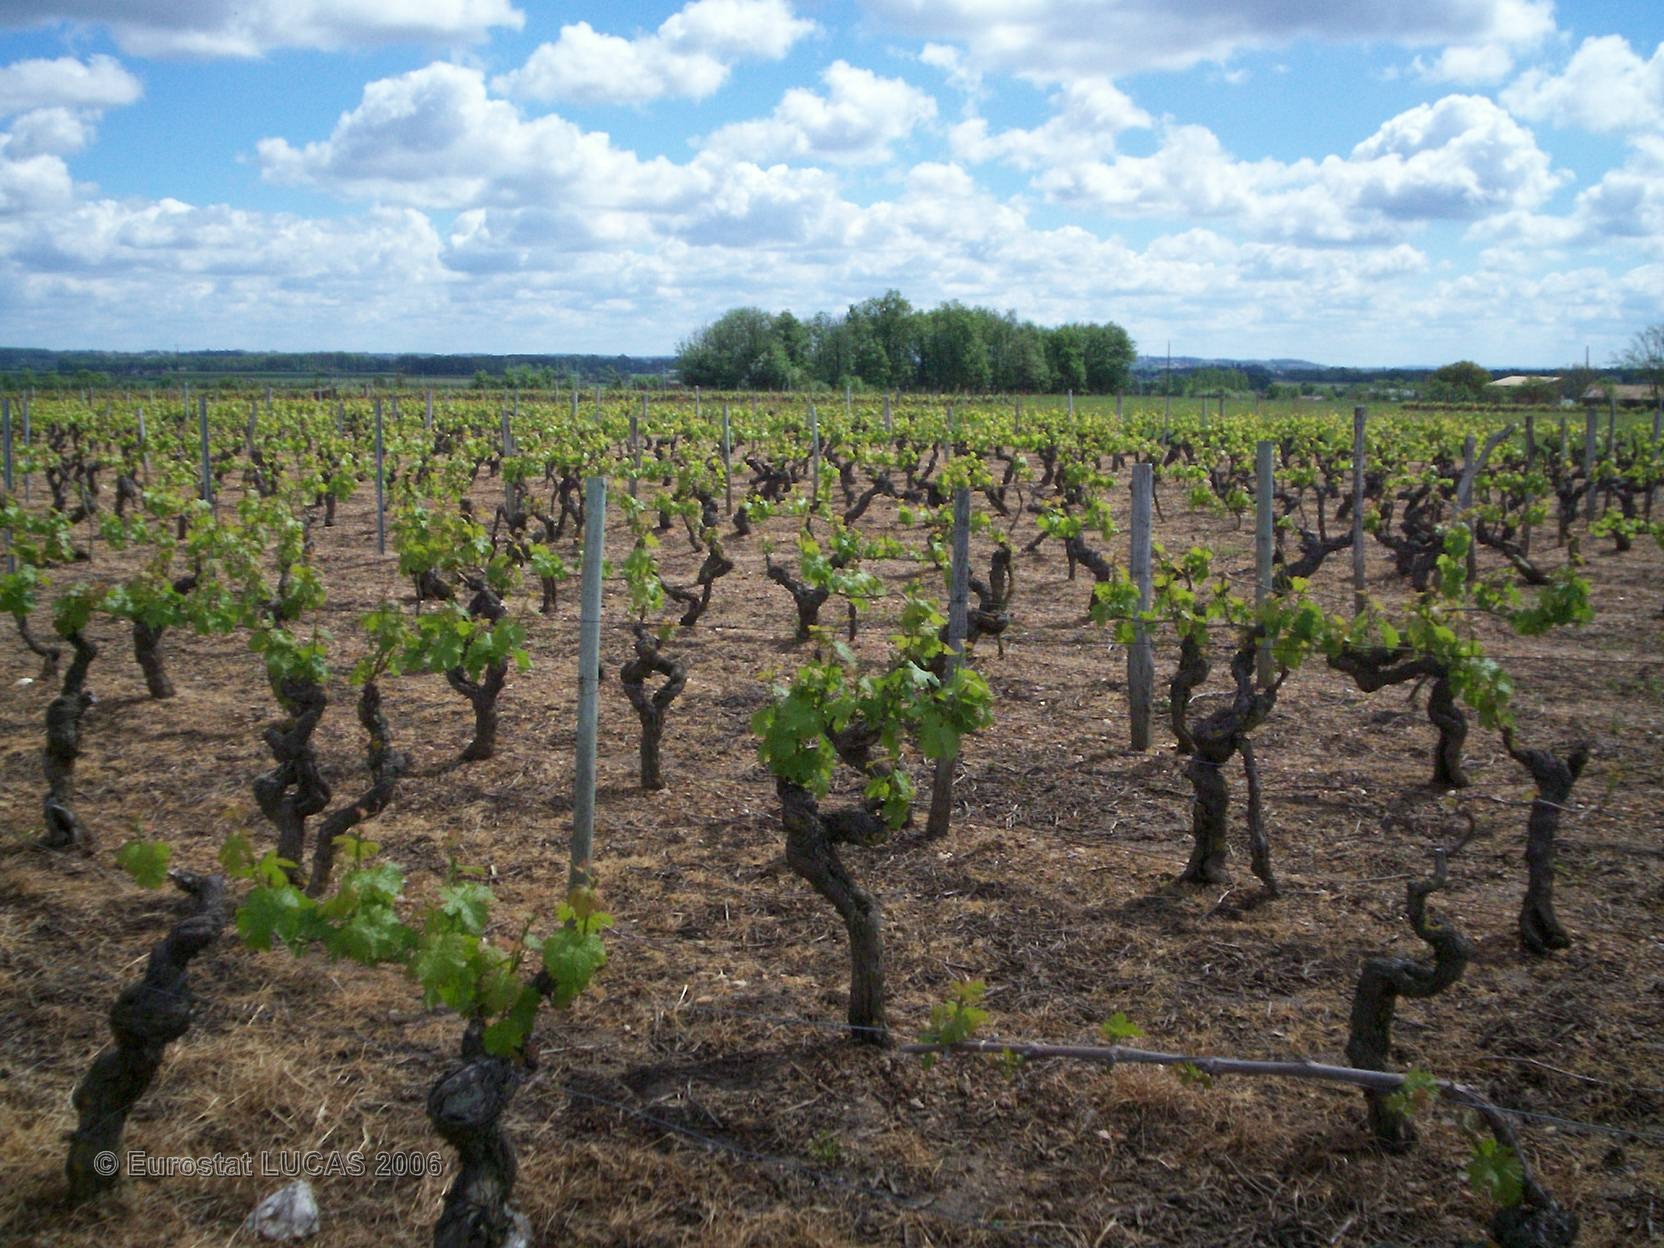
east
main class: Grassland
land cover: Grassland without tree/shrub cover
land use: Agriculture (excluding fallow land and kitchen gardens)
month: May
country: FR
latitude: 47.1362
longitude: -0.3515
